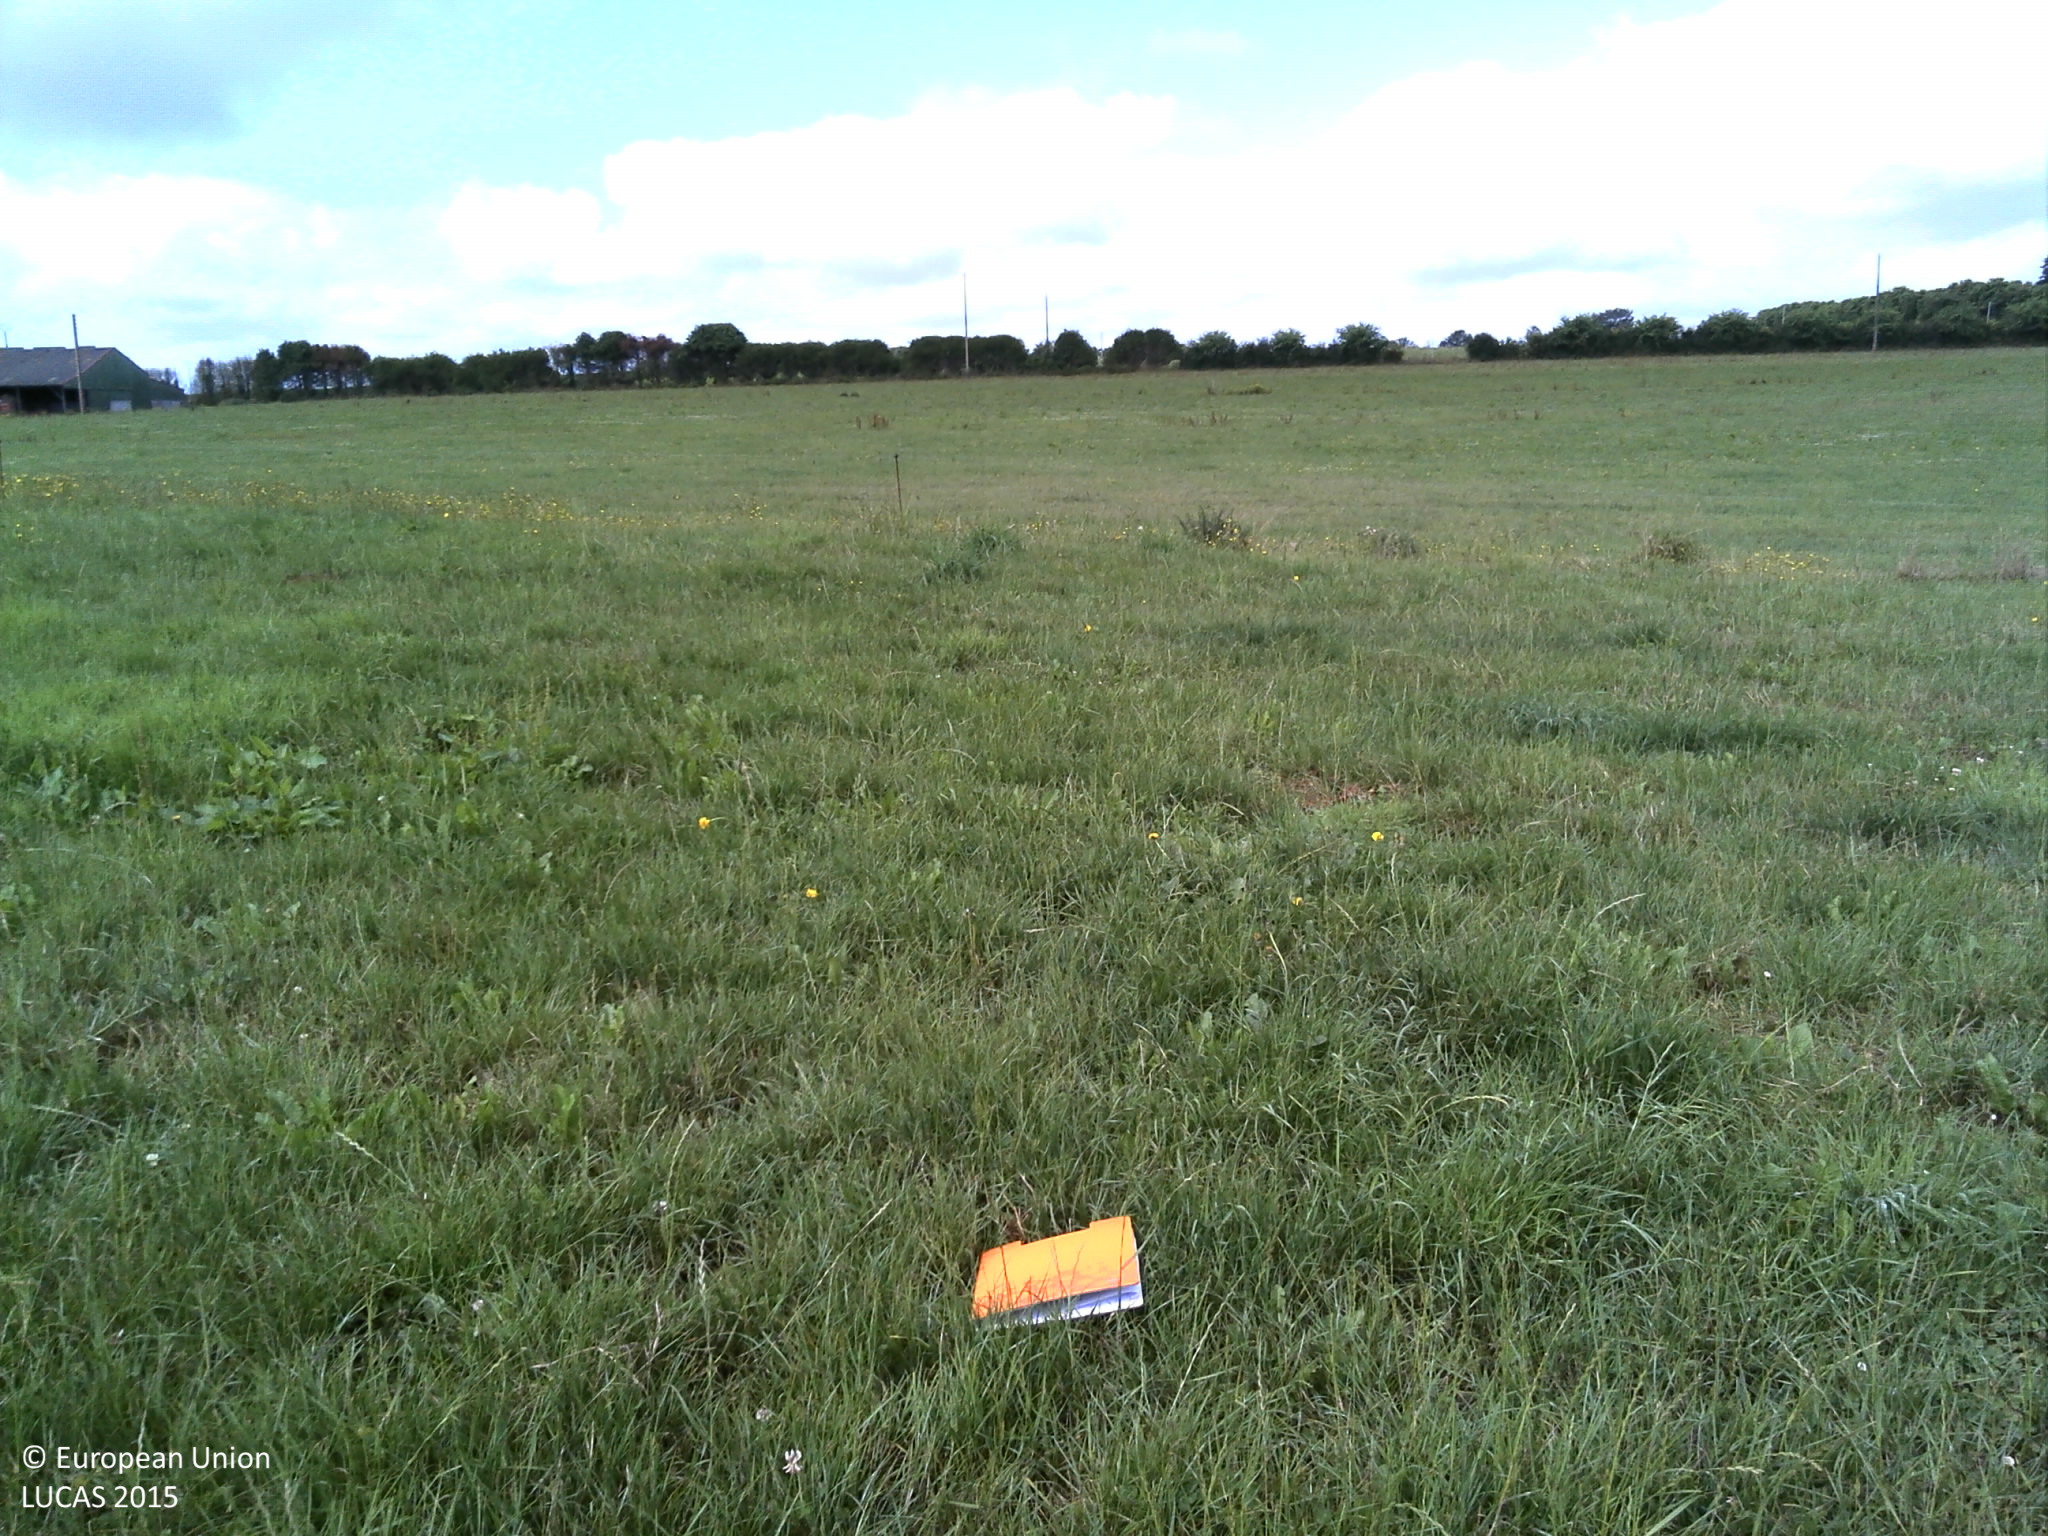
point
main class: Grassland
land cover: Grassland without tree/shrub cover
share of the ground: > 75 %
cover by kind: herbaceous plants 100 %
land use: Agriculture (excluding fallow land and kitchen gardens)
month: July
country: FR
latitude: 48.0943
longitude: -4.1204
